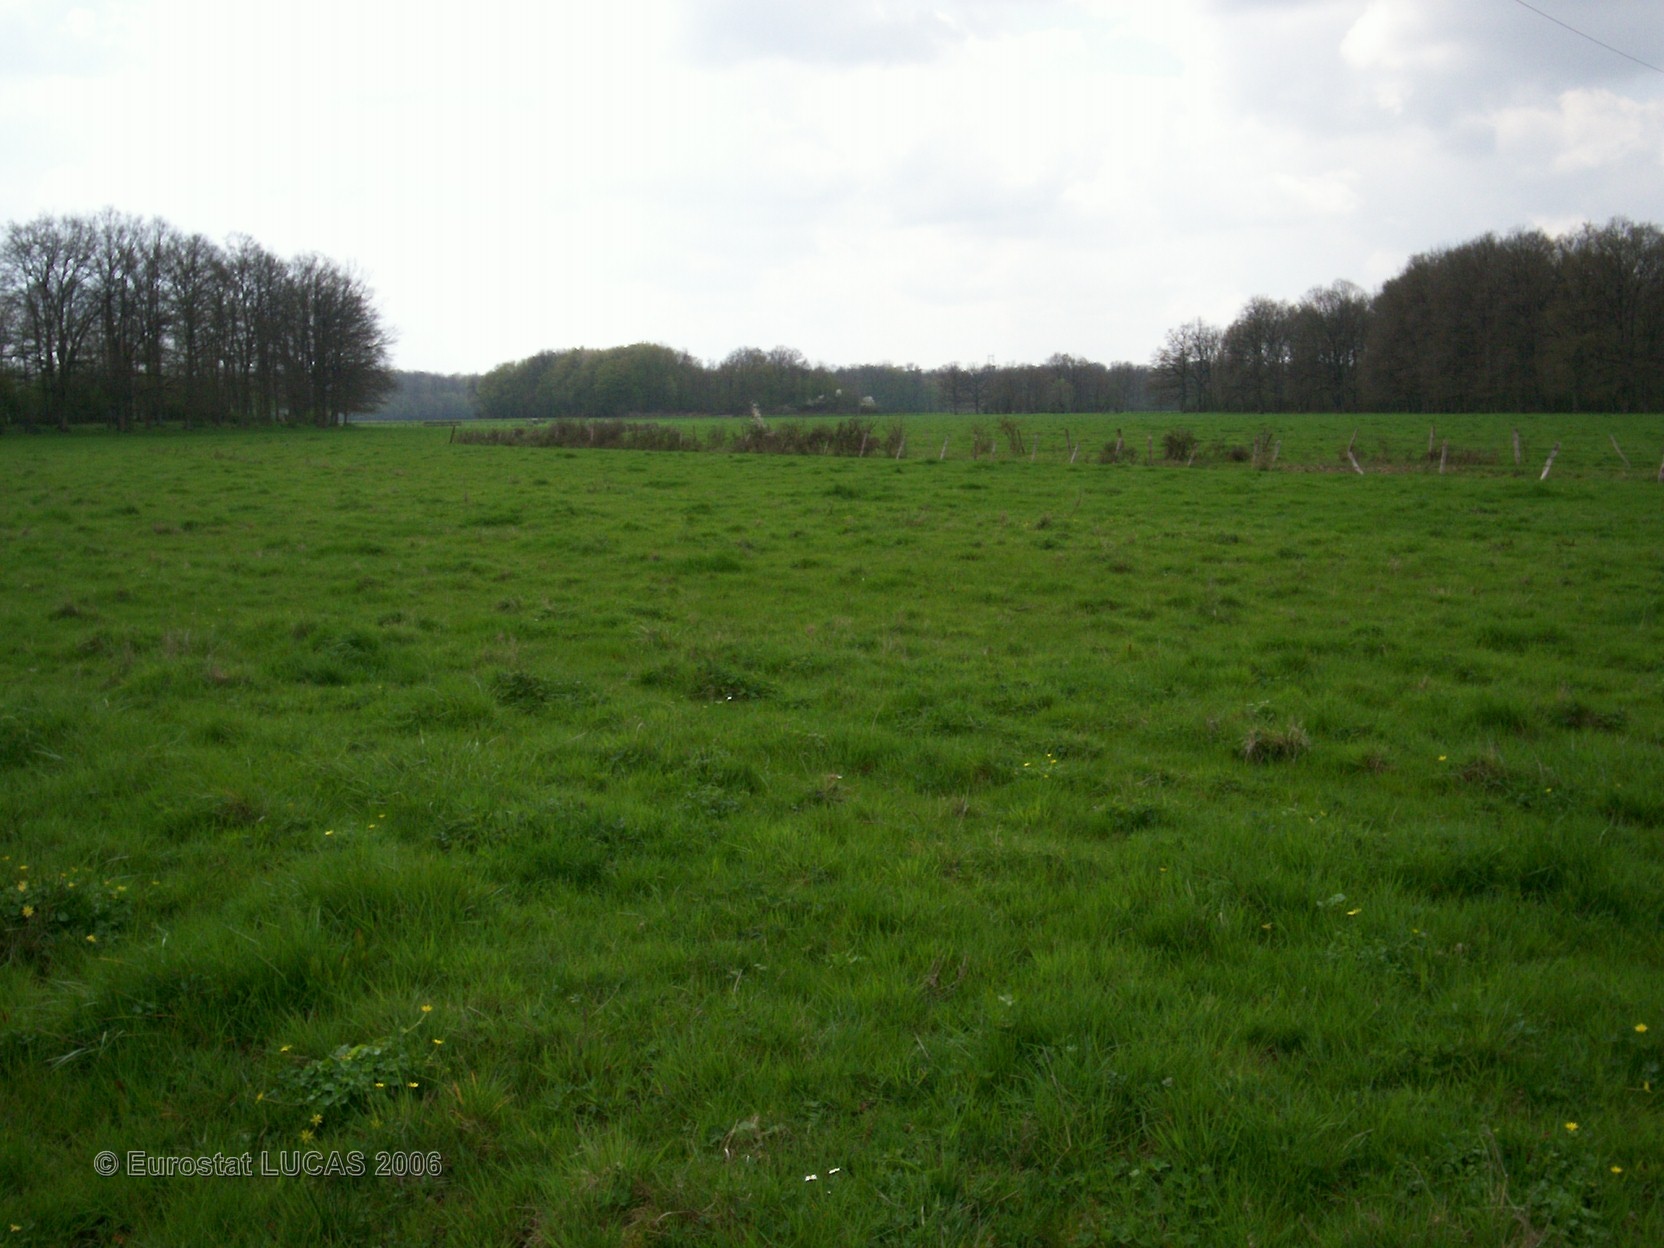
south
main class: Grassland
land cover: Grassland without tree/shrub cover
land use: Agriculture (excluding fallow land and kitchen gardens)
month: April
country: FR
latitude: 48.5264
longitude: 4.6490
